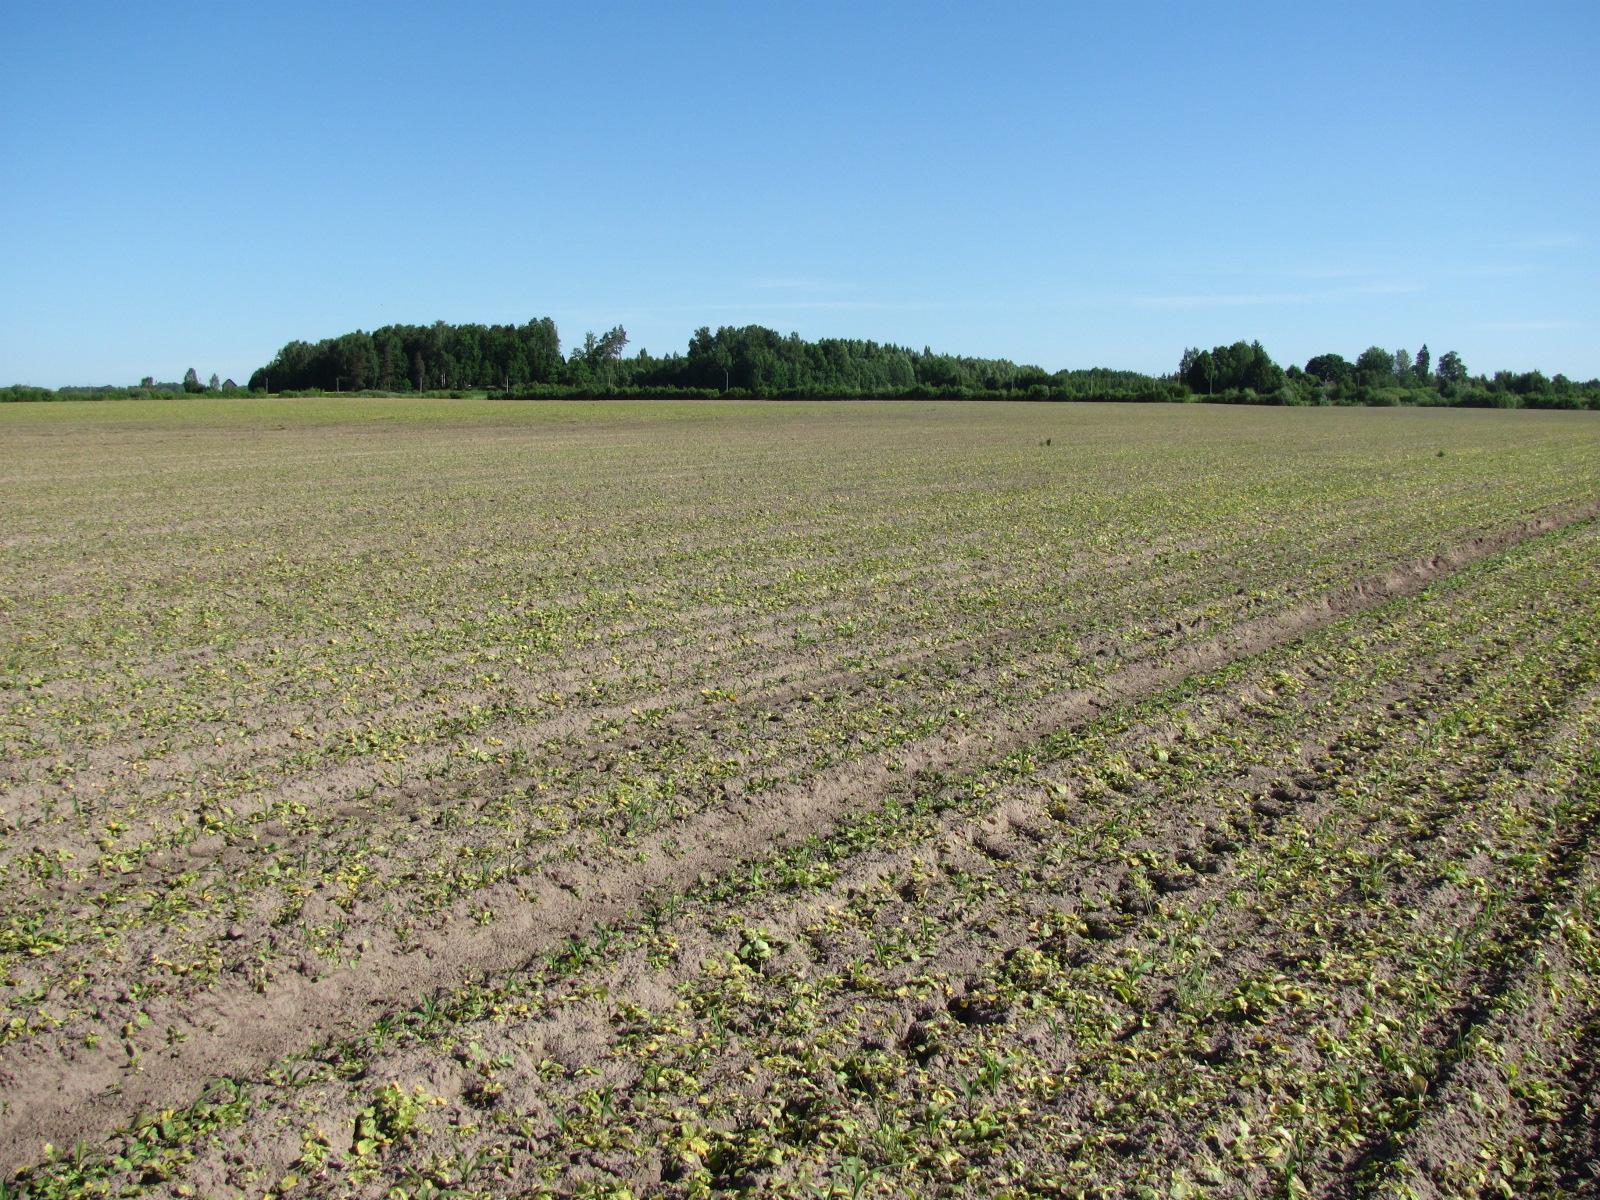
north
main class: Cropland
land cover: Maize
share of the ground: < 10 %
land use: Agriculture (excluding fallow land and kitchen gardens)
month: June
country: LV
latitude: 56.5213
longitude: 24.2479
